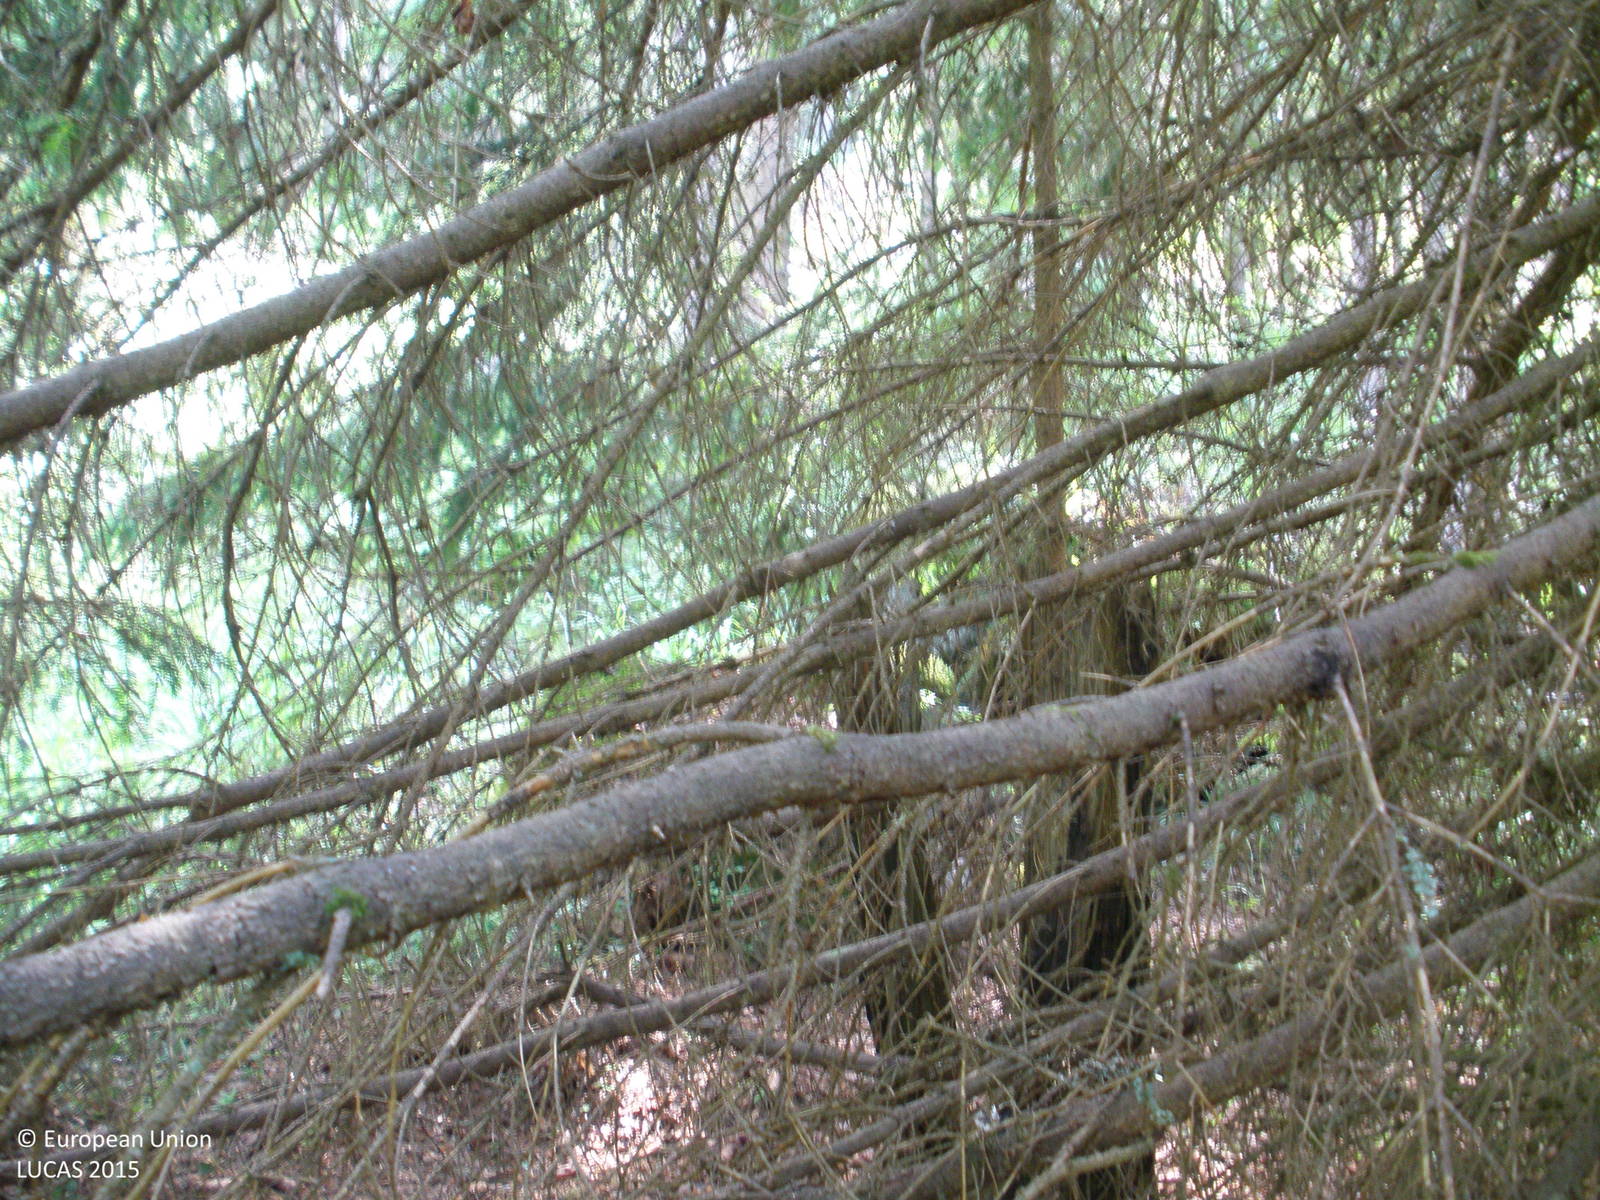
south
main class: Woodland
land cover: Pine dominated mixed woodland
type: boreal forest
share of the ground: > 75 %
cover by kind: coniferous forest trees 55 %, broadleaved forest trees 30 %, herbaceous plants 10 %, lichens and mosses 5 %
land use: Forestry
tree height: > 5 m
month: June
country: FI
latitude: 61.0240
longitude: 24.6693
